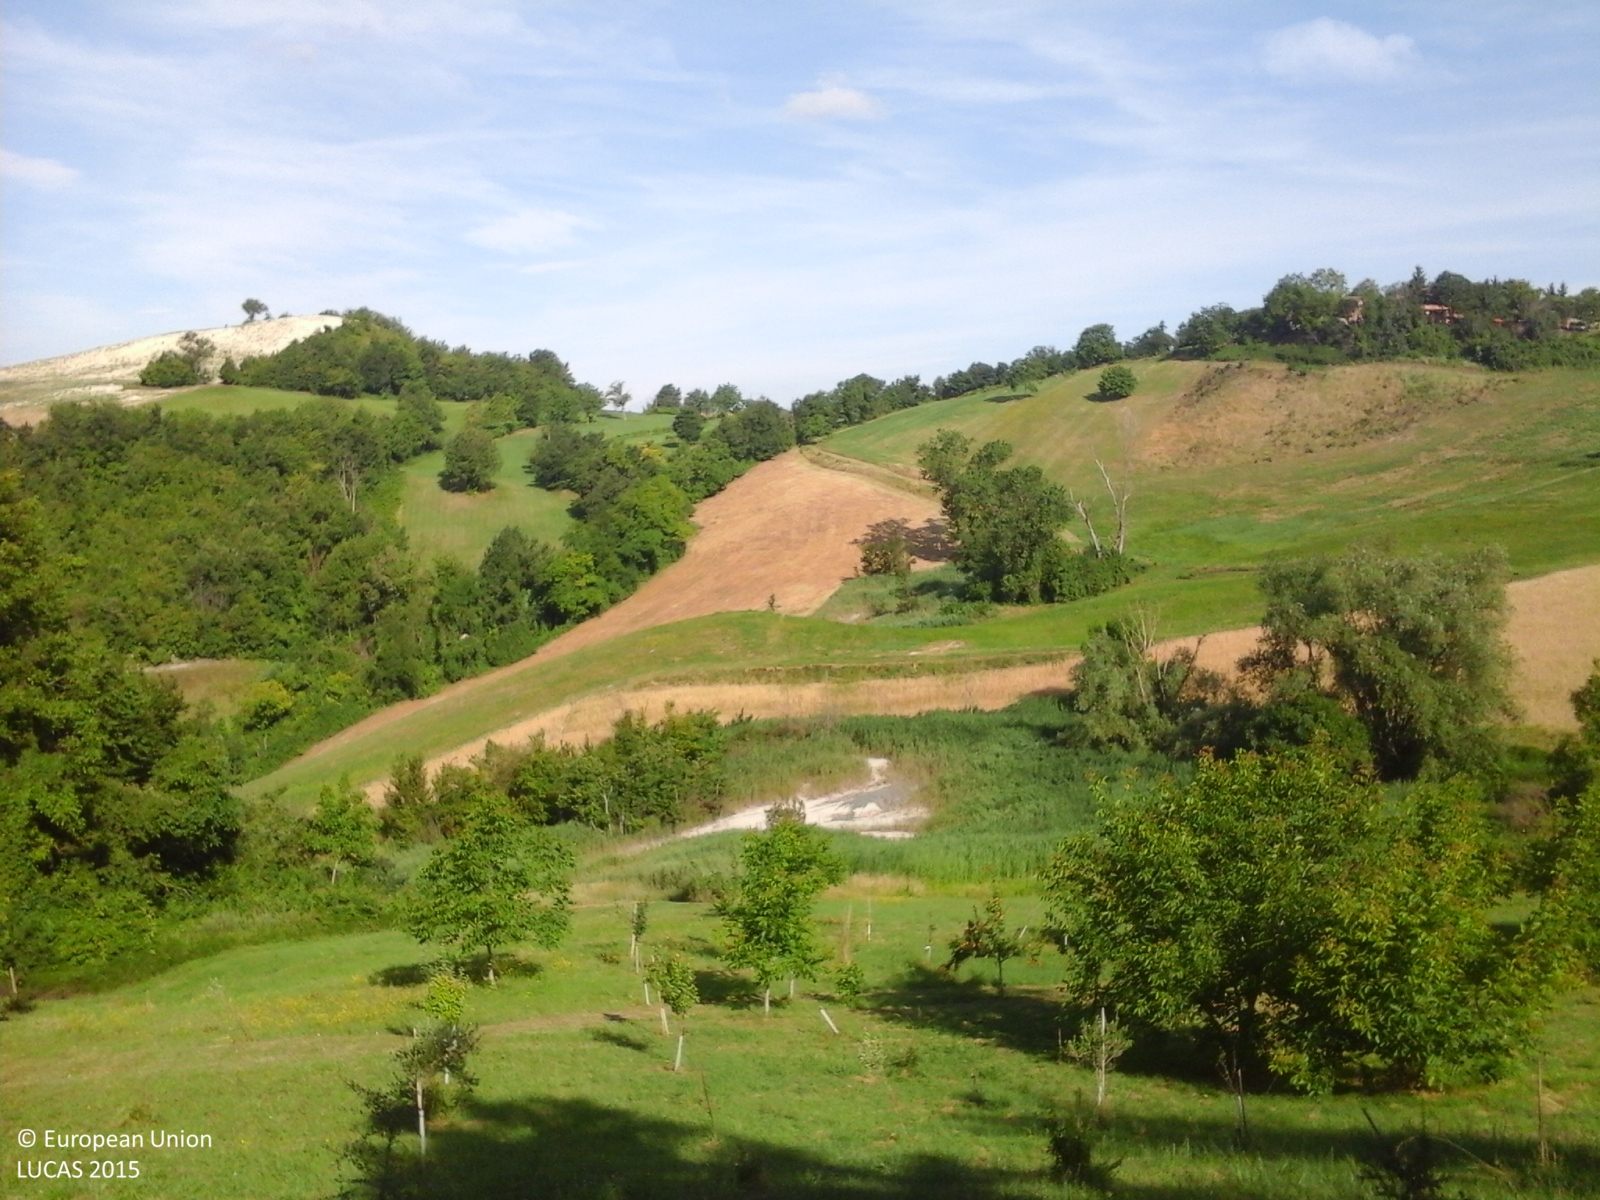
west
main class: Grassland
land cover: Grassland with sparse tree/shrub cover
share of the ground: > 75 %
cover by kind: herbaceous plants 95 %, broadleaved forest trees 5 %
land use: Agriculture (excluding fallow land and kitchen gardens)
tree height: > 5 m
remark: Clear cut
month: June
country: IT
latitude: 44.6205
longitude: 10.3395
